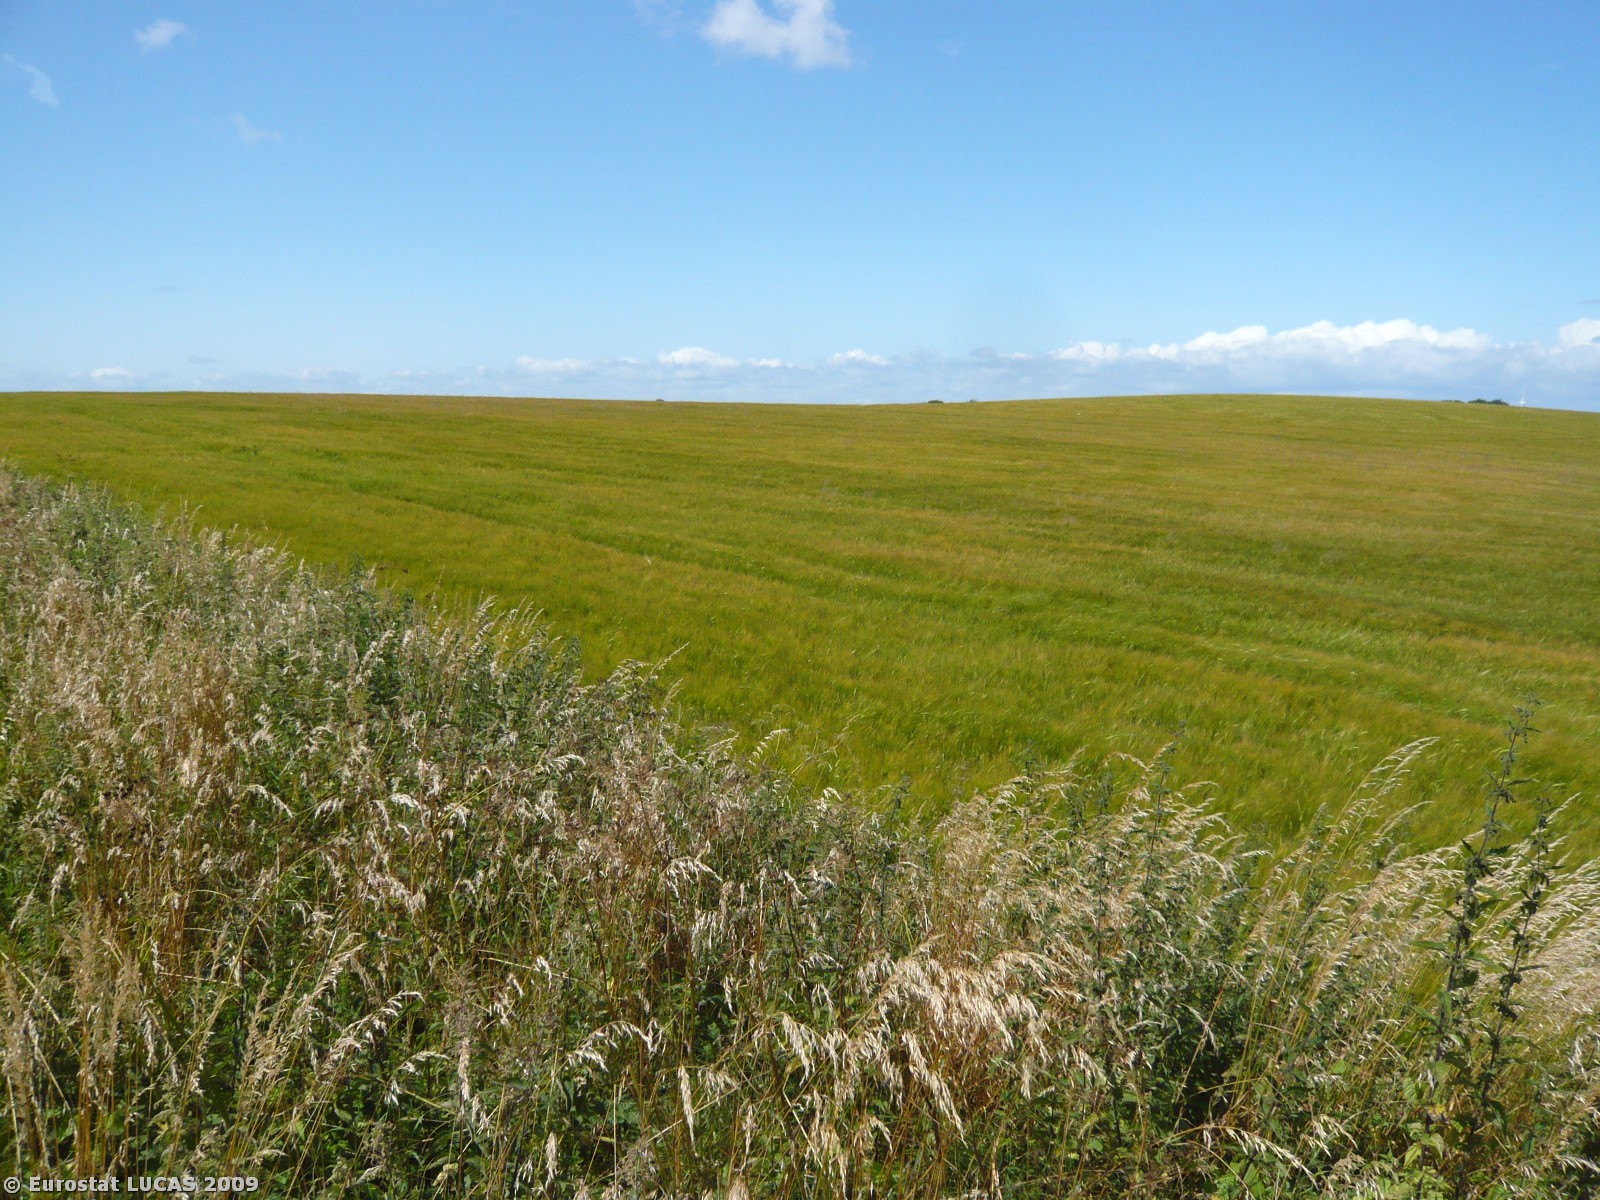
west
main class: Cropland
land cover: Barley
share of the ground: > 75 %
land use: Agriculture (excluding fallow land and kitchen gardens)
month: July
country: DK
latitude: 55.4796
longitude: 11.3437
